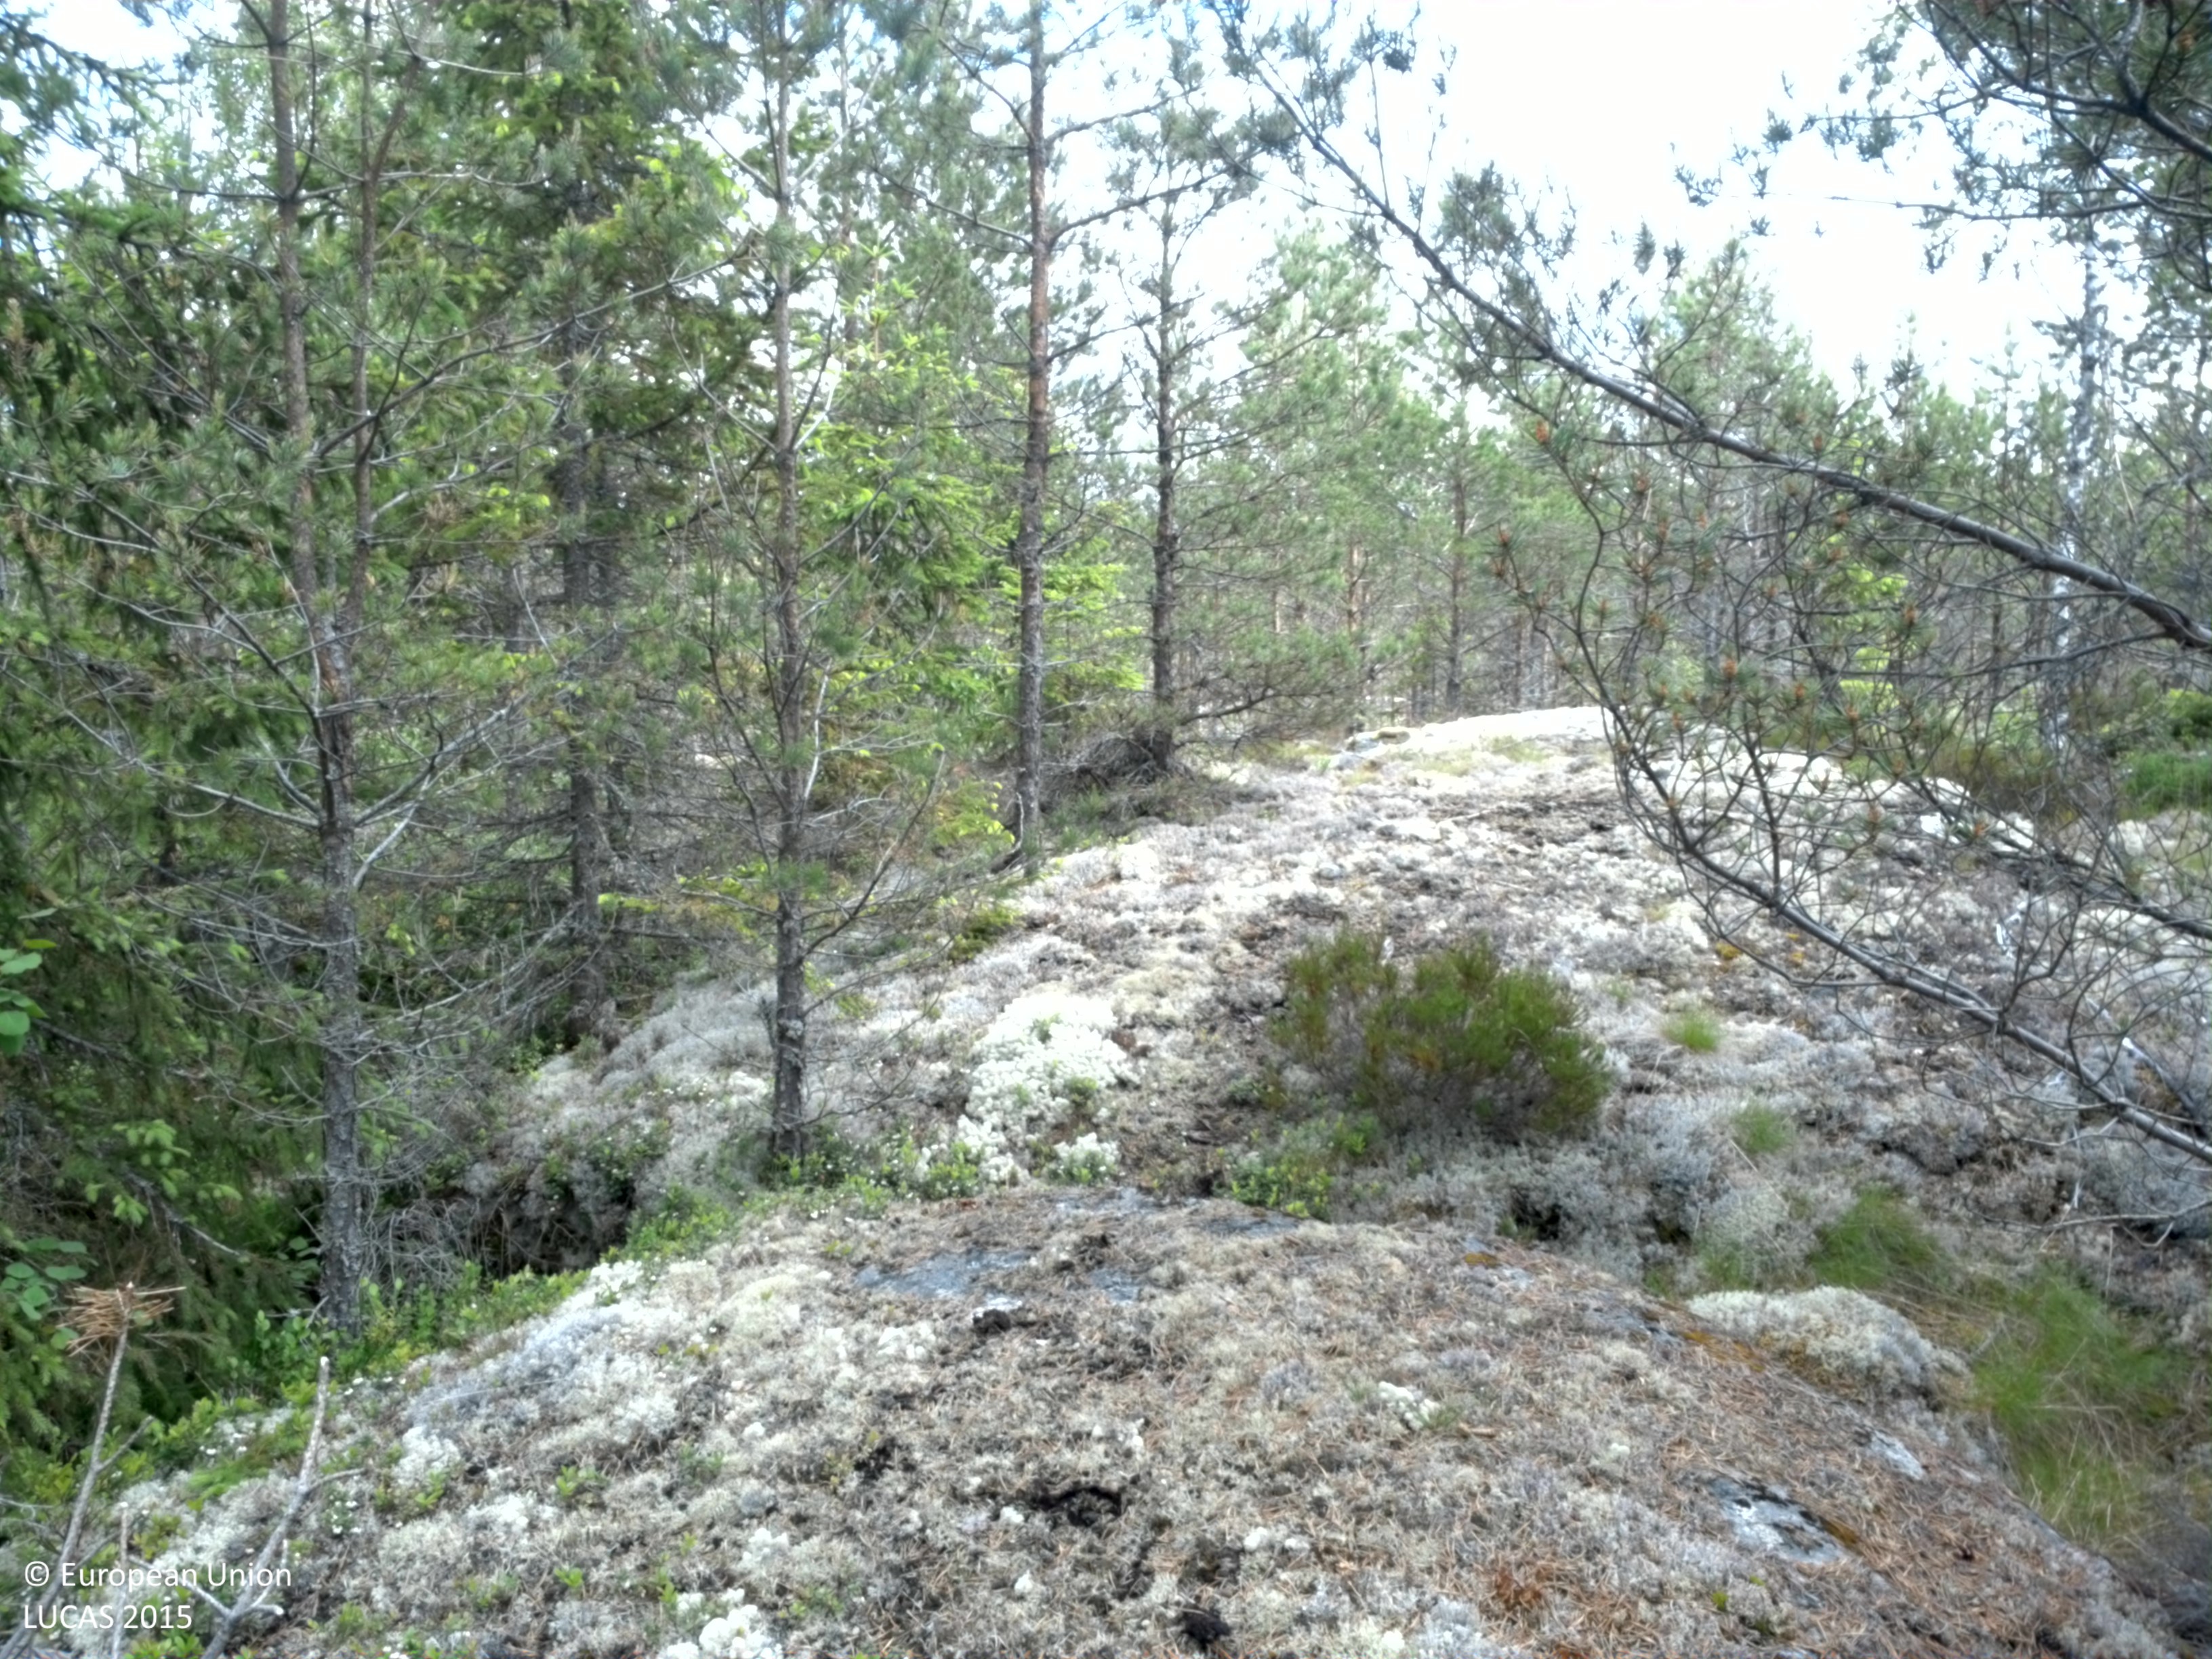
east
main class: Woodland
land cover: Pine dominated coniferous woodland
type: boreal forest
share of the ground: 25 - 50 %
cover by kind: coniferous forest trees 45 %, lichens and mosses 25 %, herbaceous plants 15 %, consolidated bare surface 10 %, broadleaved forest trees 5 %
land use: Forestry
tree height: > 5 m
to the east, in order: Pine dominated coniferous woodland; Grass margins; Paved roads, cycling and walking lanes; Grass margins; Pine dominated coniferous woodland; Other coniferous woodland; Pine dominated coniferous woodland
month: June
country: SE
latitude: 59.9852
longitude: 17.0712
